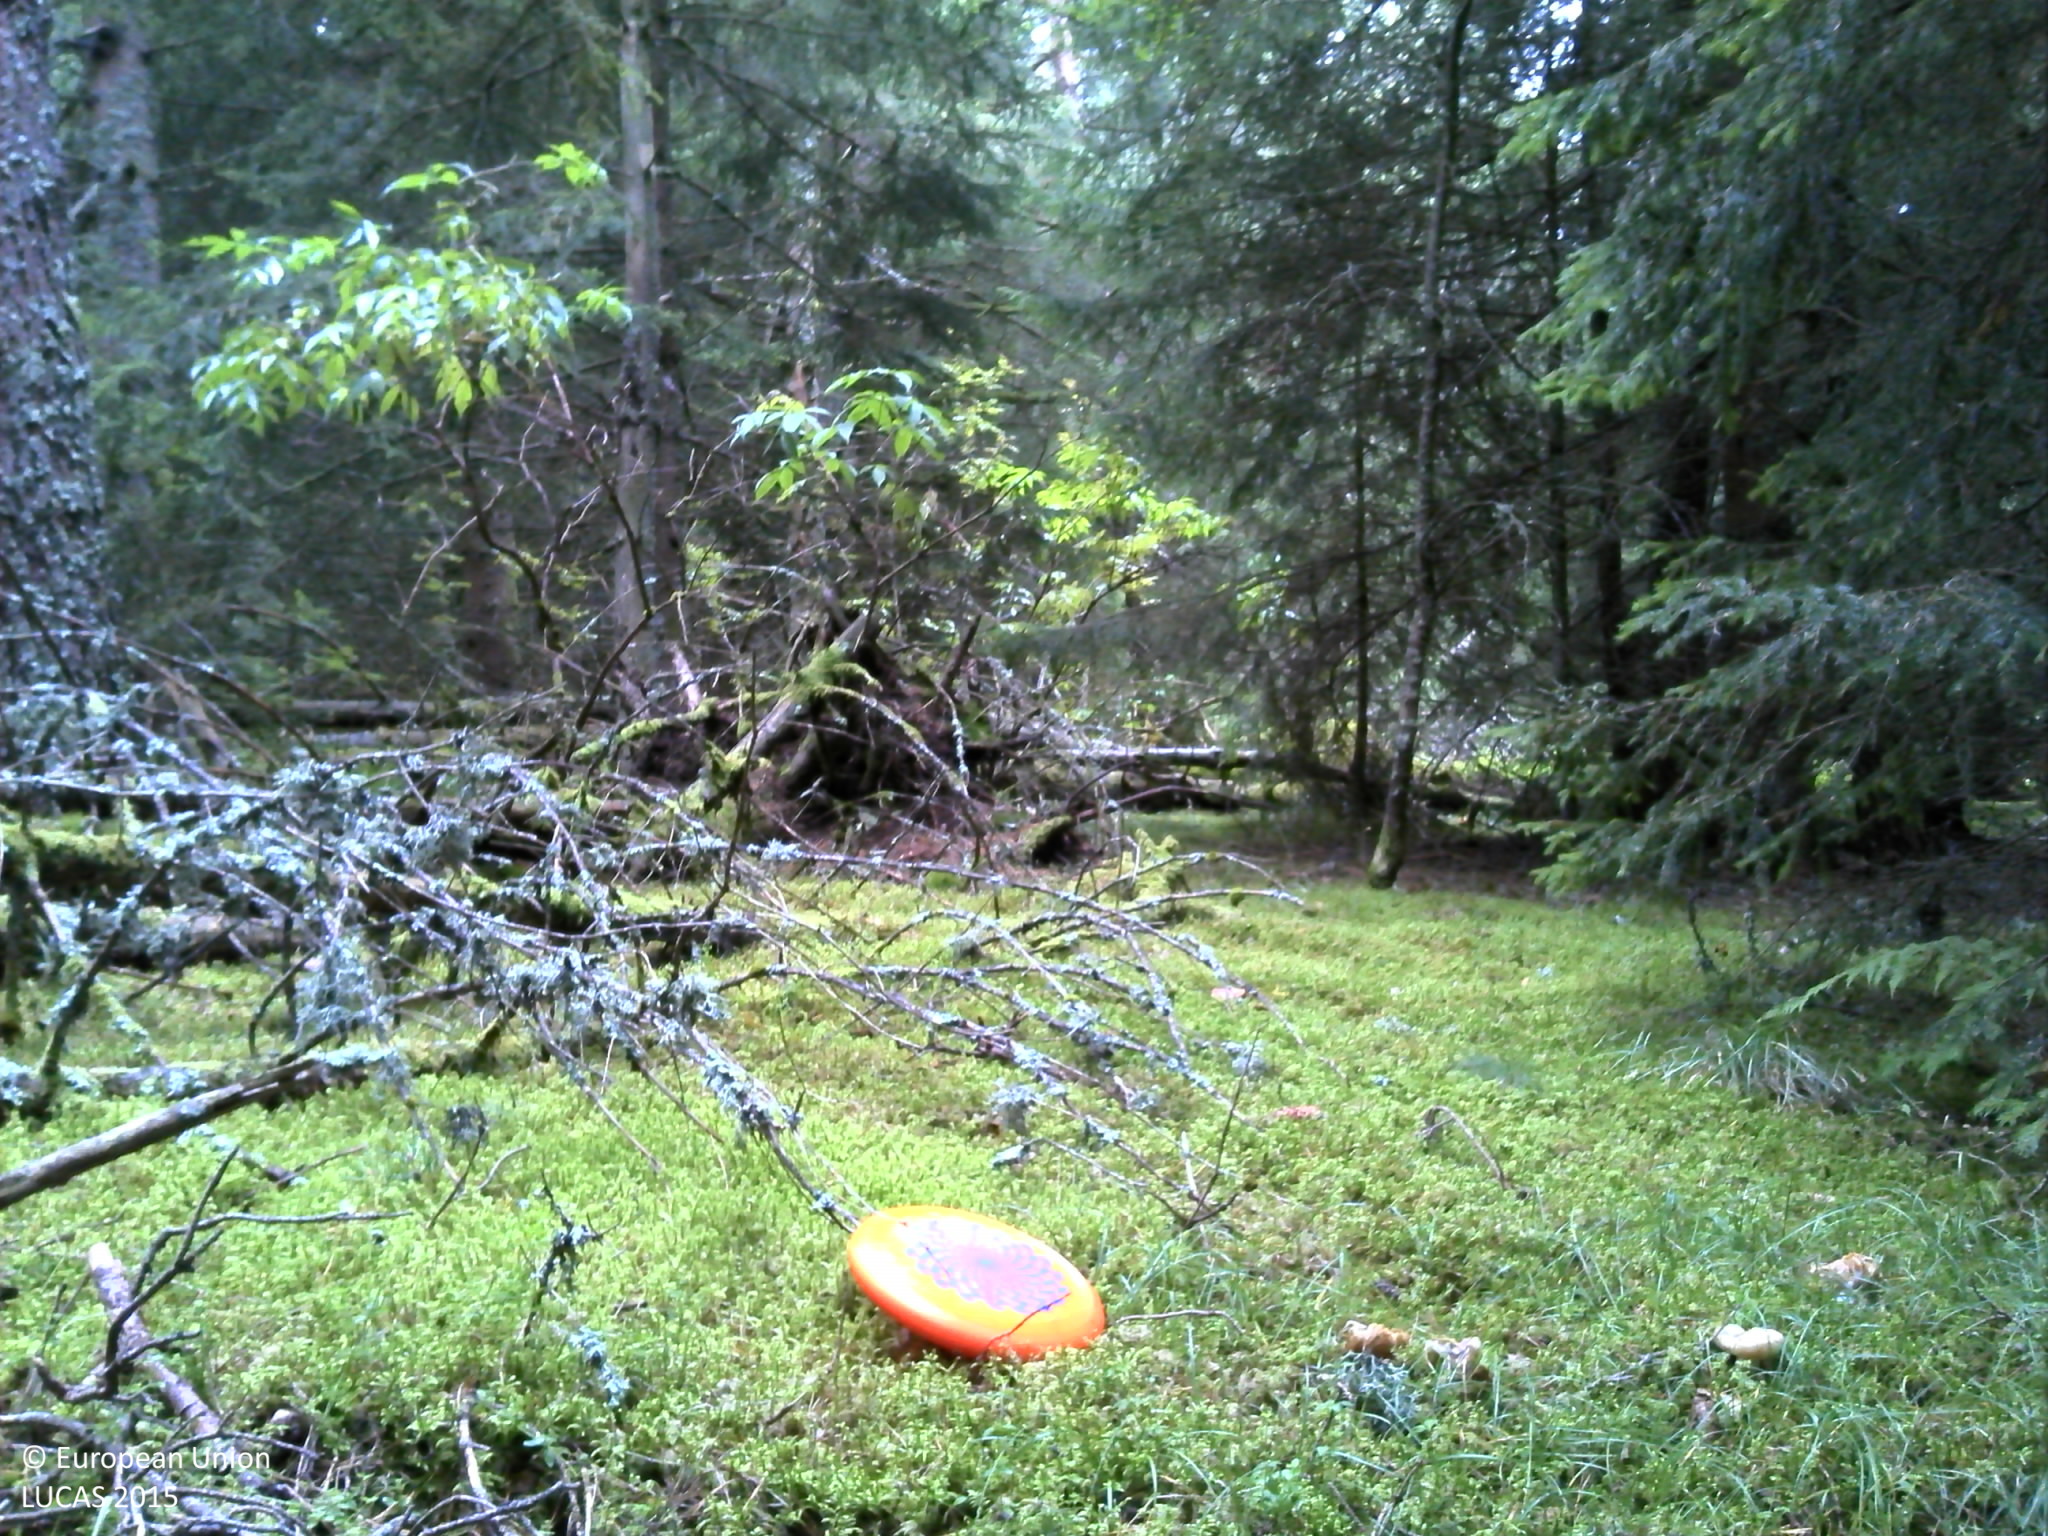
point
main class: Woodland
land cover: Spruce dominated coniferous woodland
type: alpine coniferous forest
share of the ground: > 75 %
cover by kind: coniferous forest trees 75 %, lichens and mosses 25 %
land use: Forestry
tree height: > 5 m
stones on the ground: < 10 %
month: September
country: FR
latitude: 45.6436
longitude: 2.8786
